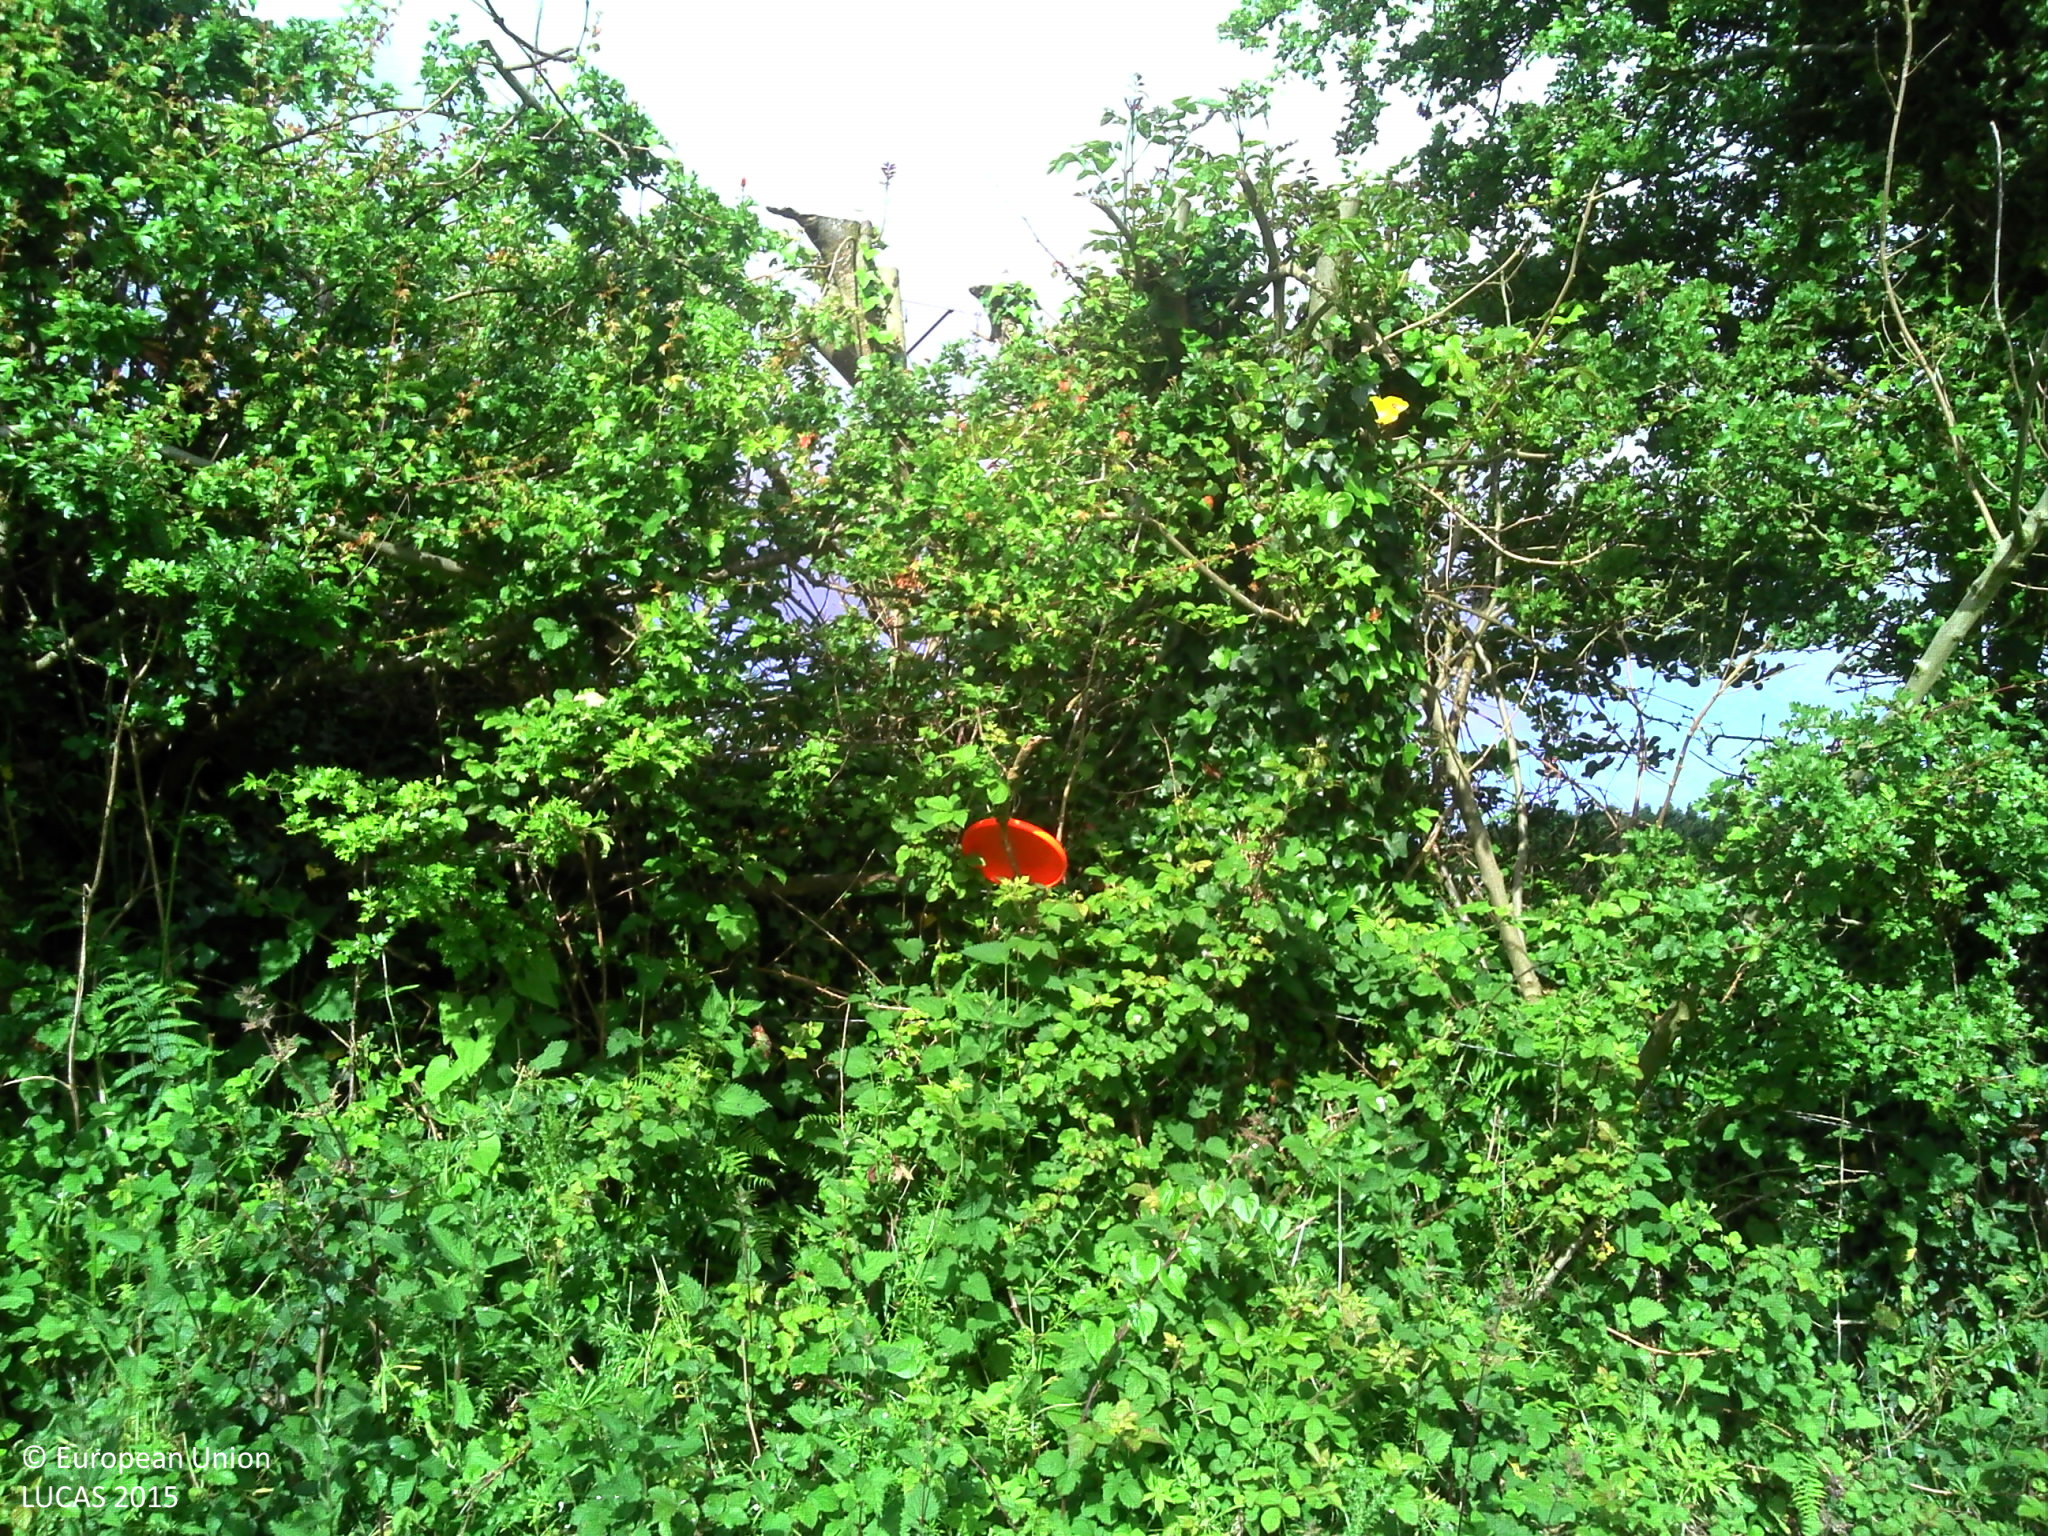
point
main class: Grassland
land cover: Grassland without tree/shrub cover
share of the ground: > 75 %
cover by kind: herbaceous plants 100 %
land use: Agriculture (excluding fallow land and kitchen gardens)
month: June
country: FR
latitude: 49.5519
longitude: -1.7890
